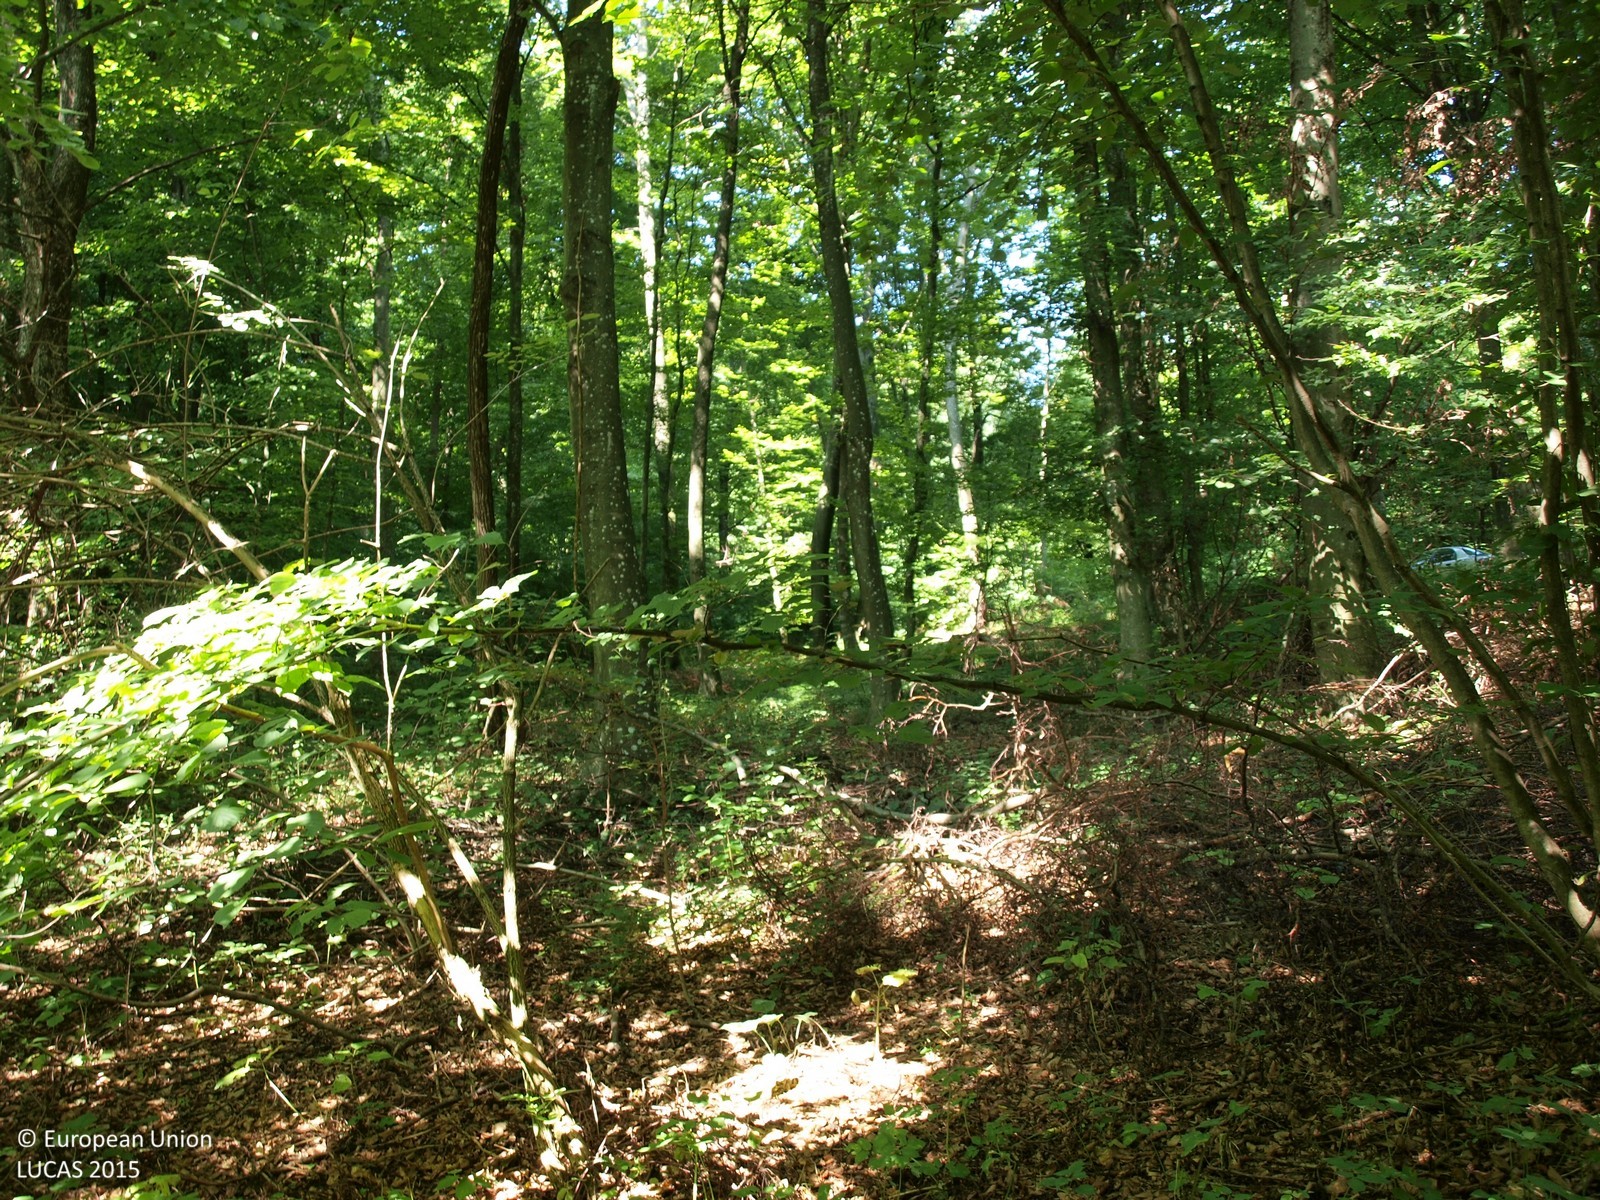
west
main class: Woodland
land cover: Broadleaved woodland
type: beech forest
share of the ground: > 75 %
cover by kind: broadleaved forest trees 100 %
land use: Forestry
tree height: > 5 m
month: August
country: HR
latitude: 46.1020
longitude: 16.4550
